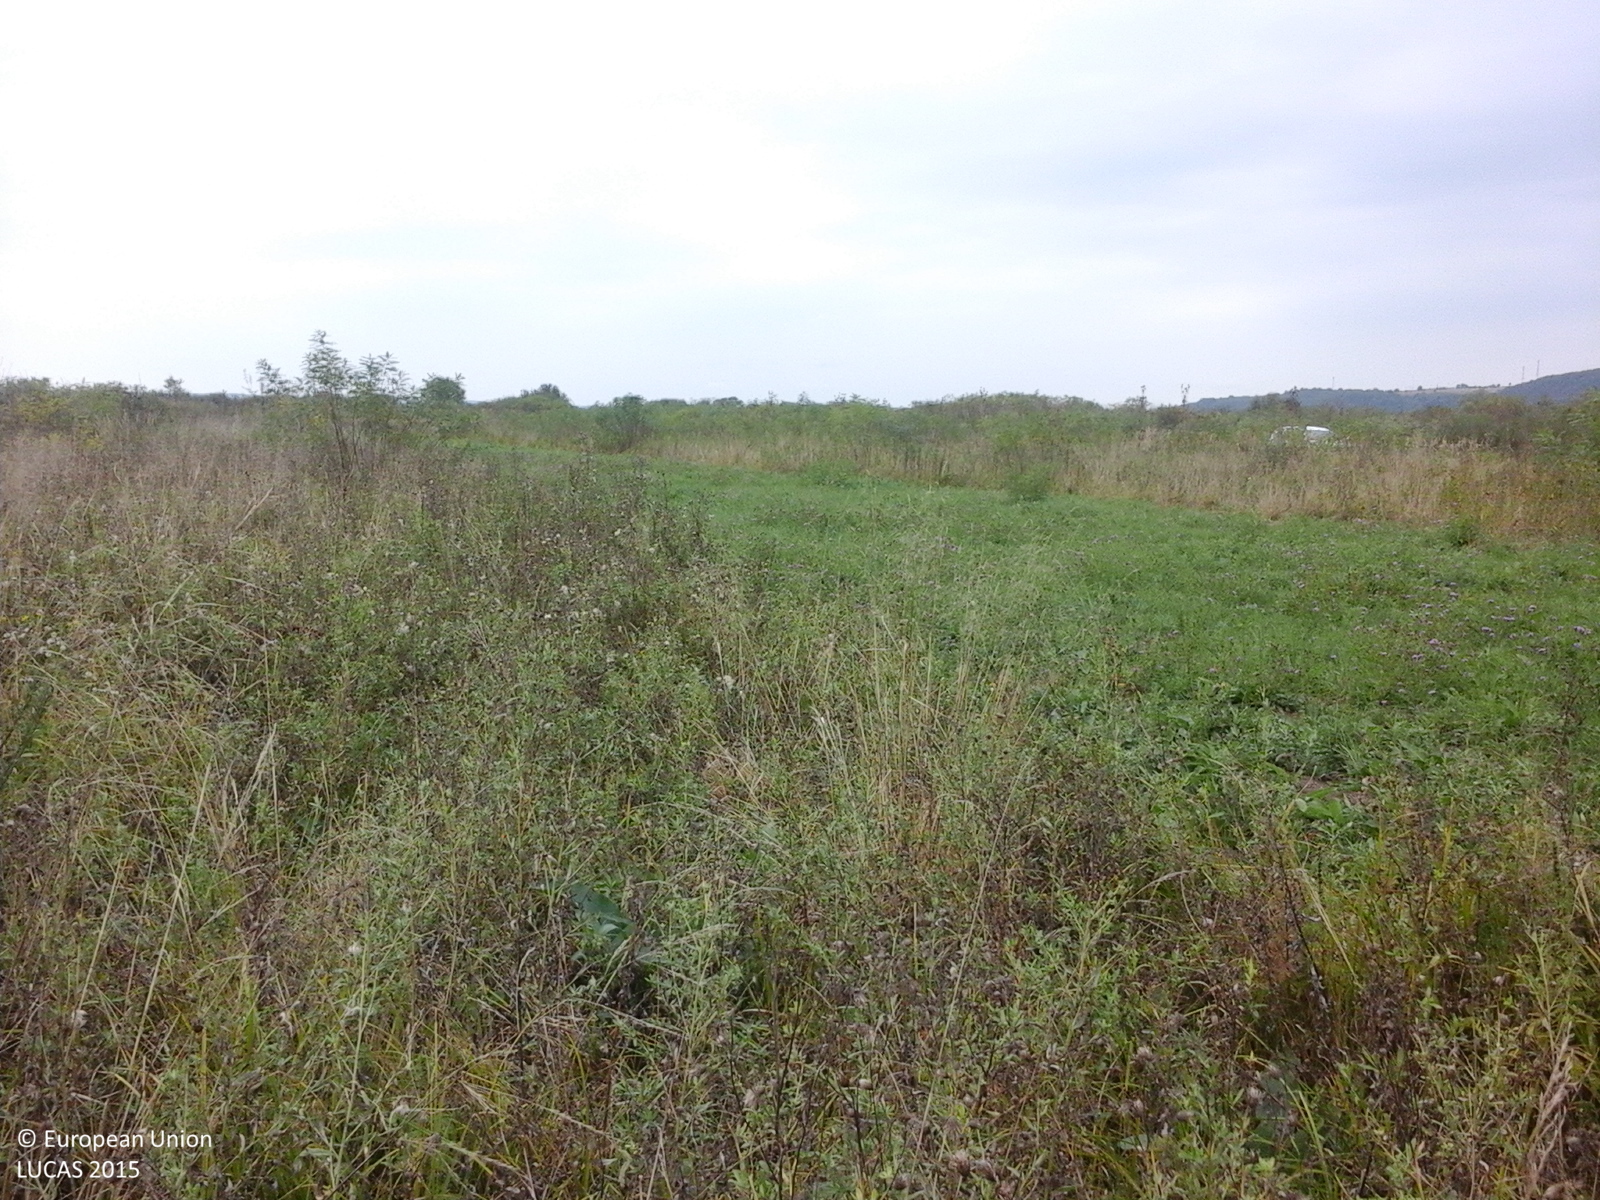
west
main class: Grassland
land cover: Spontaneously vegetated surfaces
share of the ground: > 75 %
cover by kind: herbaceous plants 100 %
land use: Fallow land
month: September
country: RO
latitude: 45.9936
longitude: 22.2195
